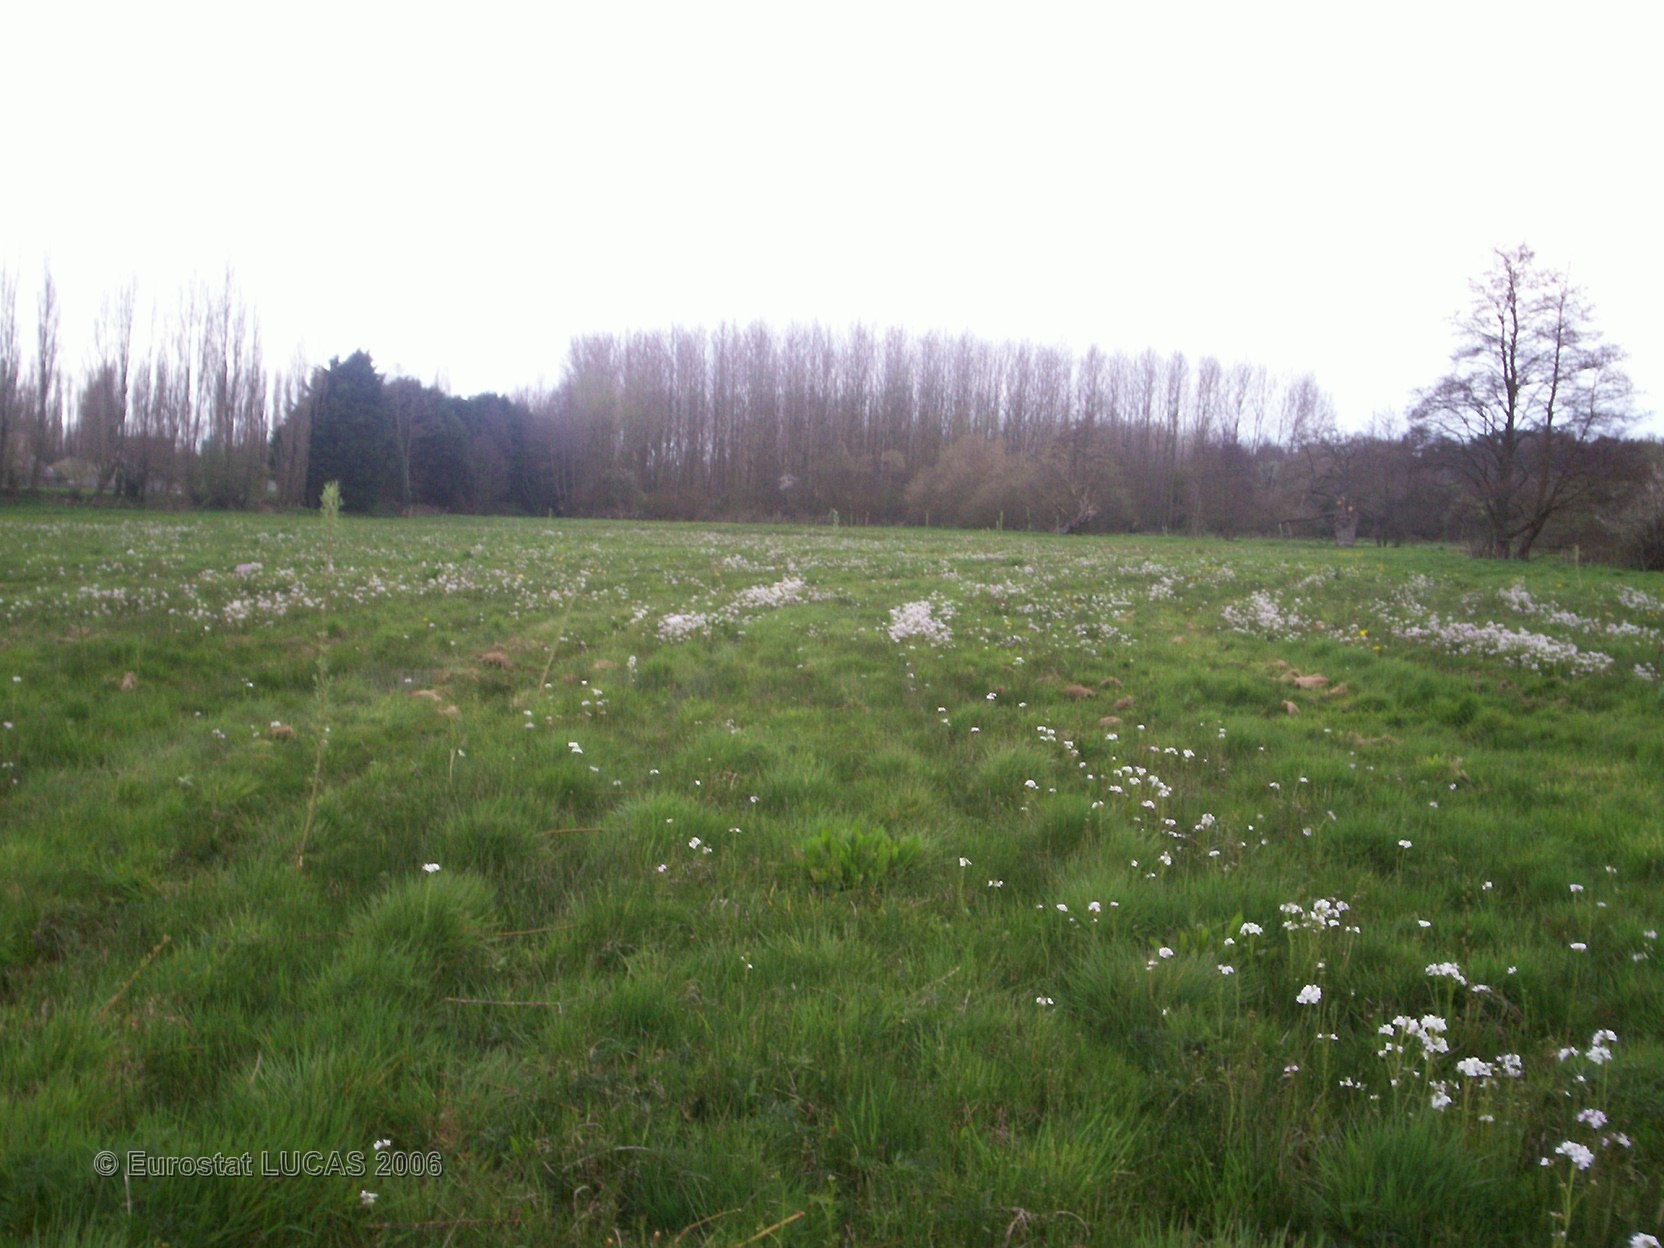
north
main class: Woodland
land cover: Broadleaved forest
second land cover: Grassland with sparse tree/shrub cover
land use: Agriculture (excluding fallow land and kitchen gardens)
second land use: Forestry
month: April
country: FR
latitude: 48.4568
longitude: -2.4883
